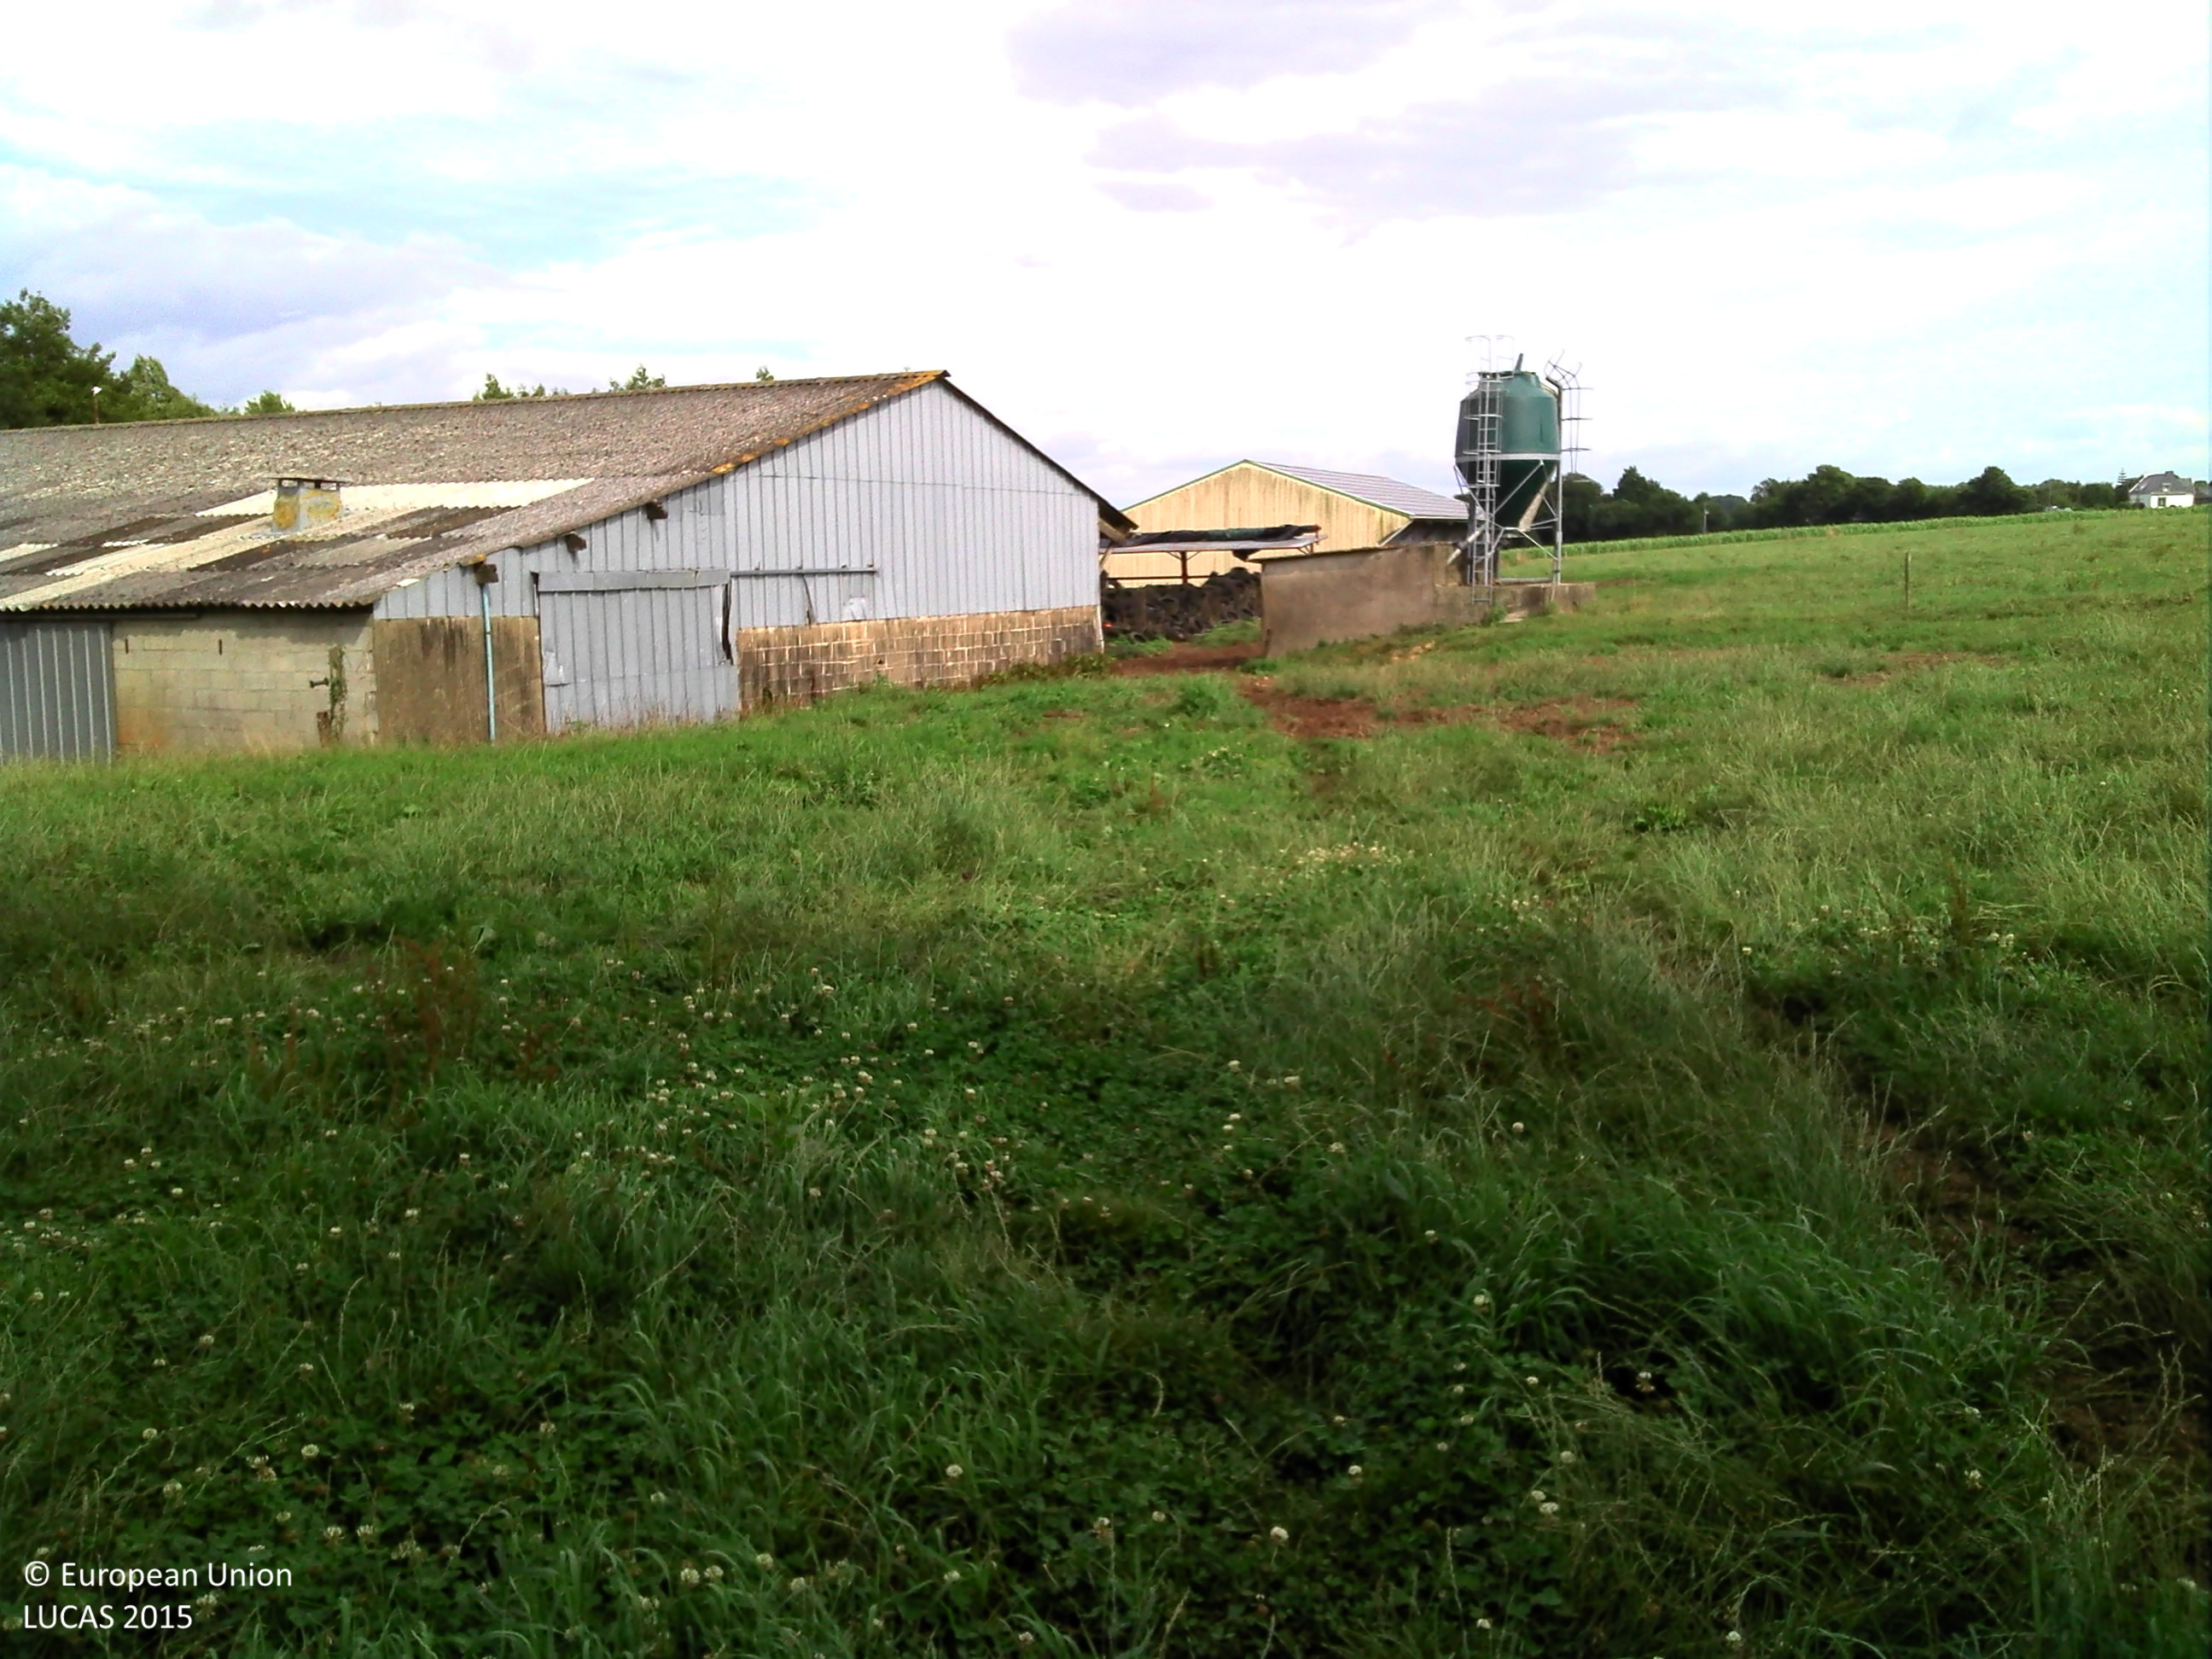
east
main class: Grassland
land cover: Grassland without tree/shrub cover
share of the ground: > 75 %
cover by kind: herbaceous plants 70 %, consolidated bare surface 30 %
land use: Agriculture (excluding fallow land and kitchen gardens)
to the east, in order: Grassland without tree/shrub cover; Fences; Grassland without tree/shrub cover; Artificial constructions in urban areas; Grassland without tree/shrub cover; Tracks
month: July
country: FR
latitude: 47.9112
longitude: -2.9511
